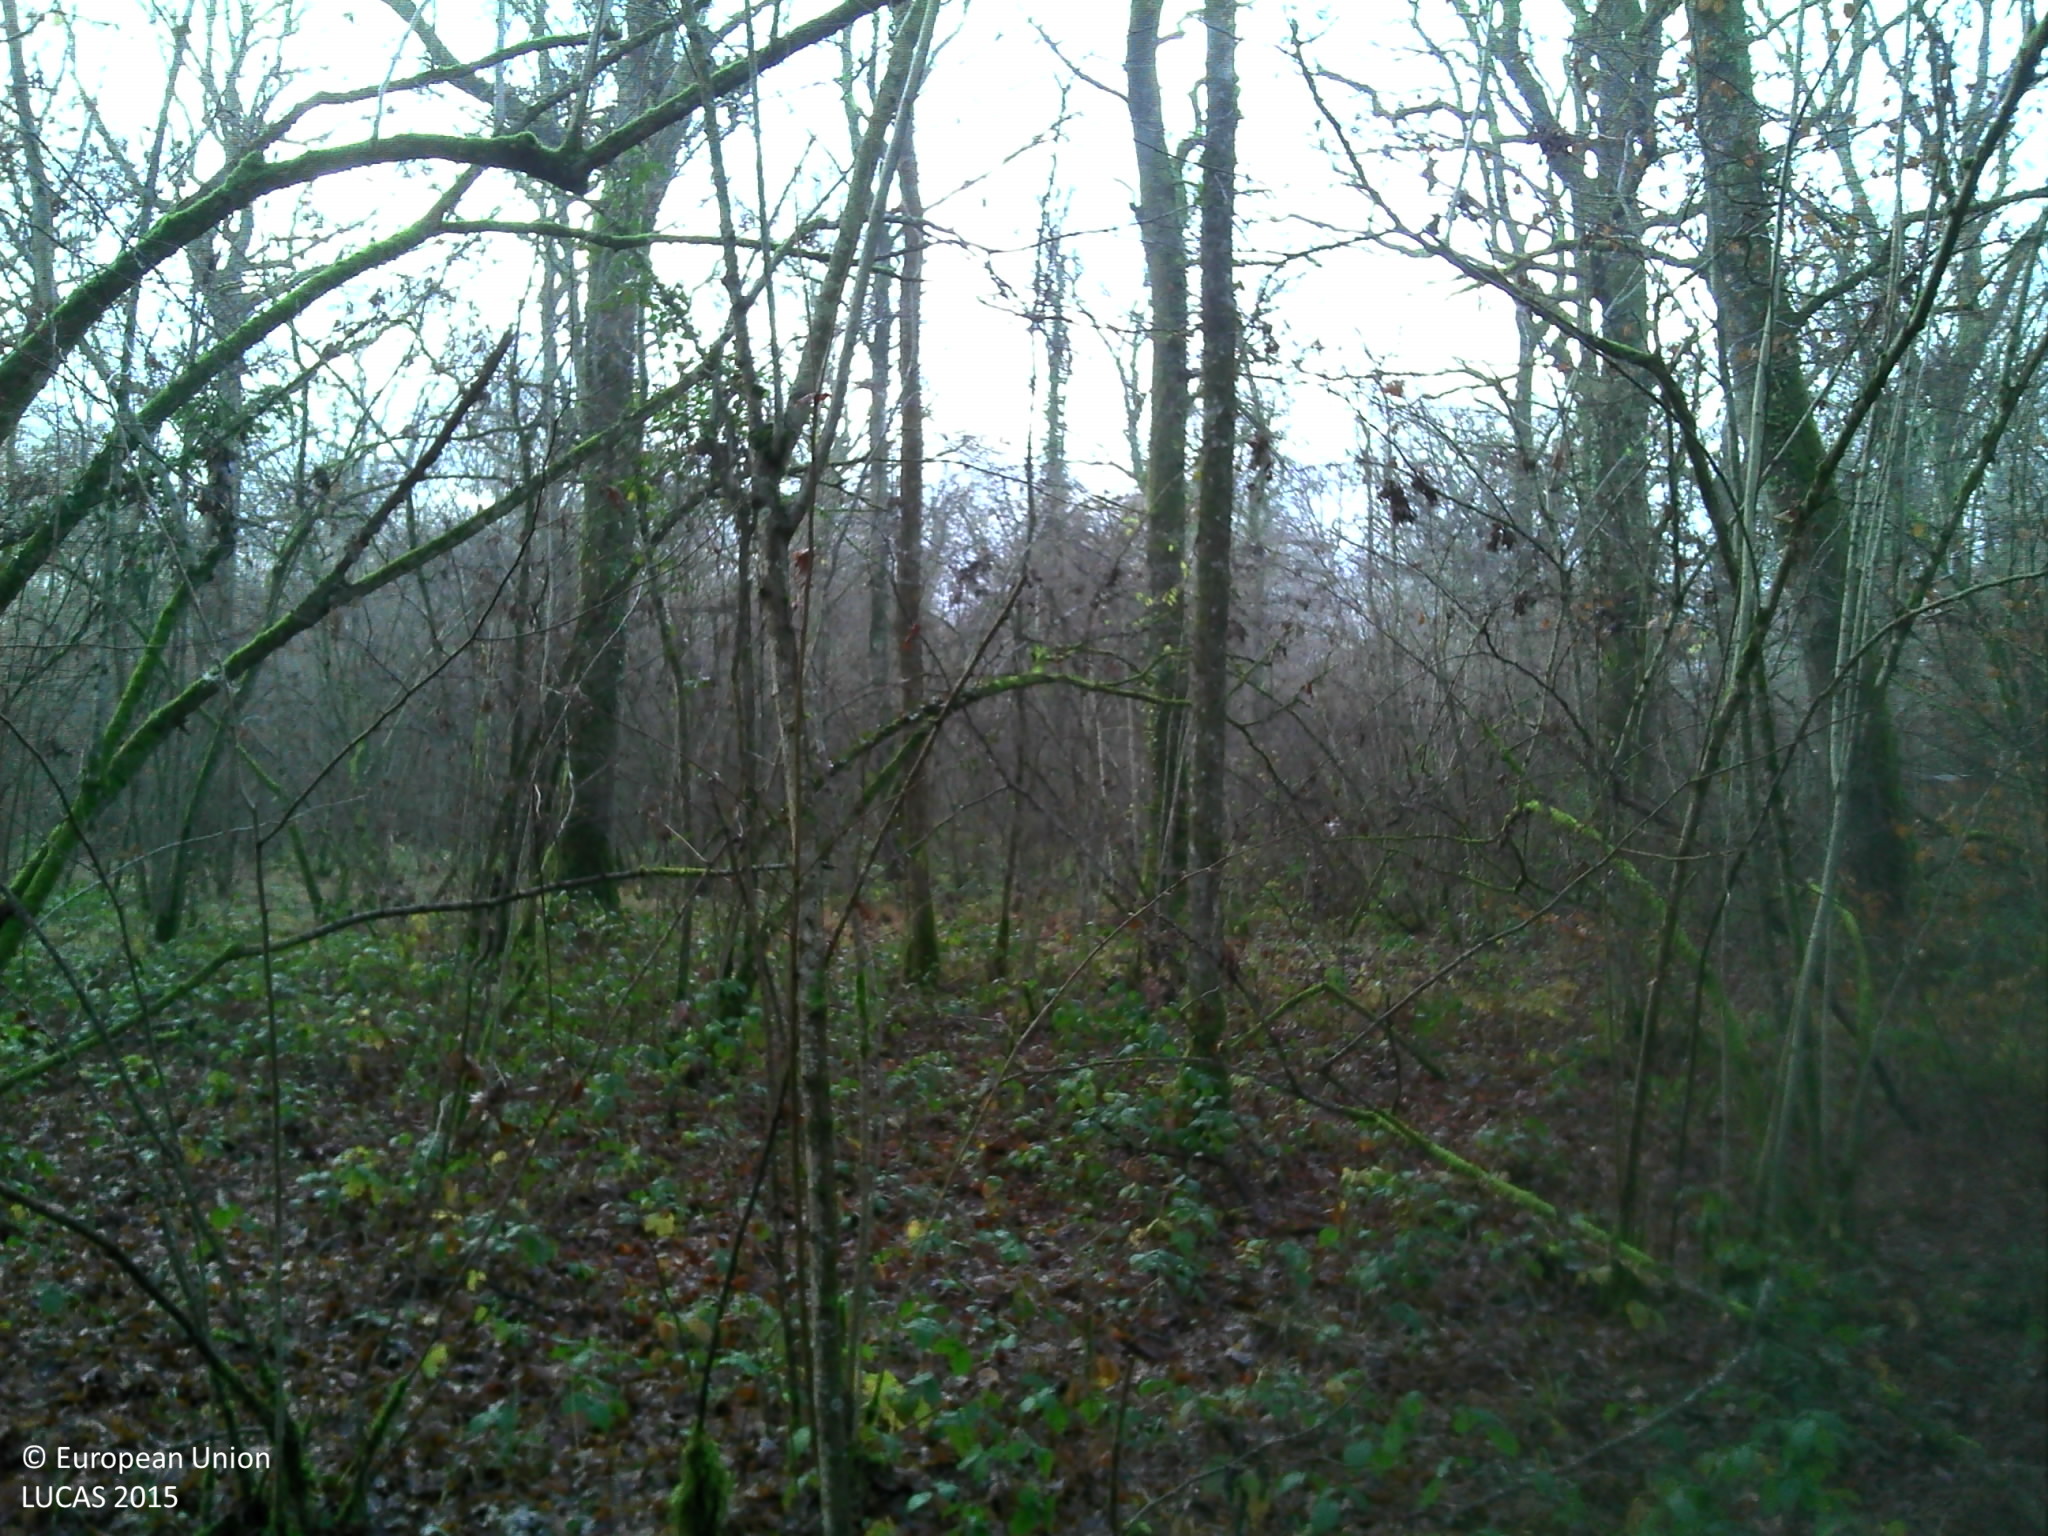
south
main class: Woodland
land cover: Broadleaved woodland
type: mesophytic deciduous forest
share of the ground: > 75 %
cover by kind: broadleaved forest trees 100 %
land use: Forestry
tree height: > 5 m
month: December
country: FR
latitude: 47.0132
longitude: 5.0682
